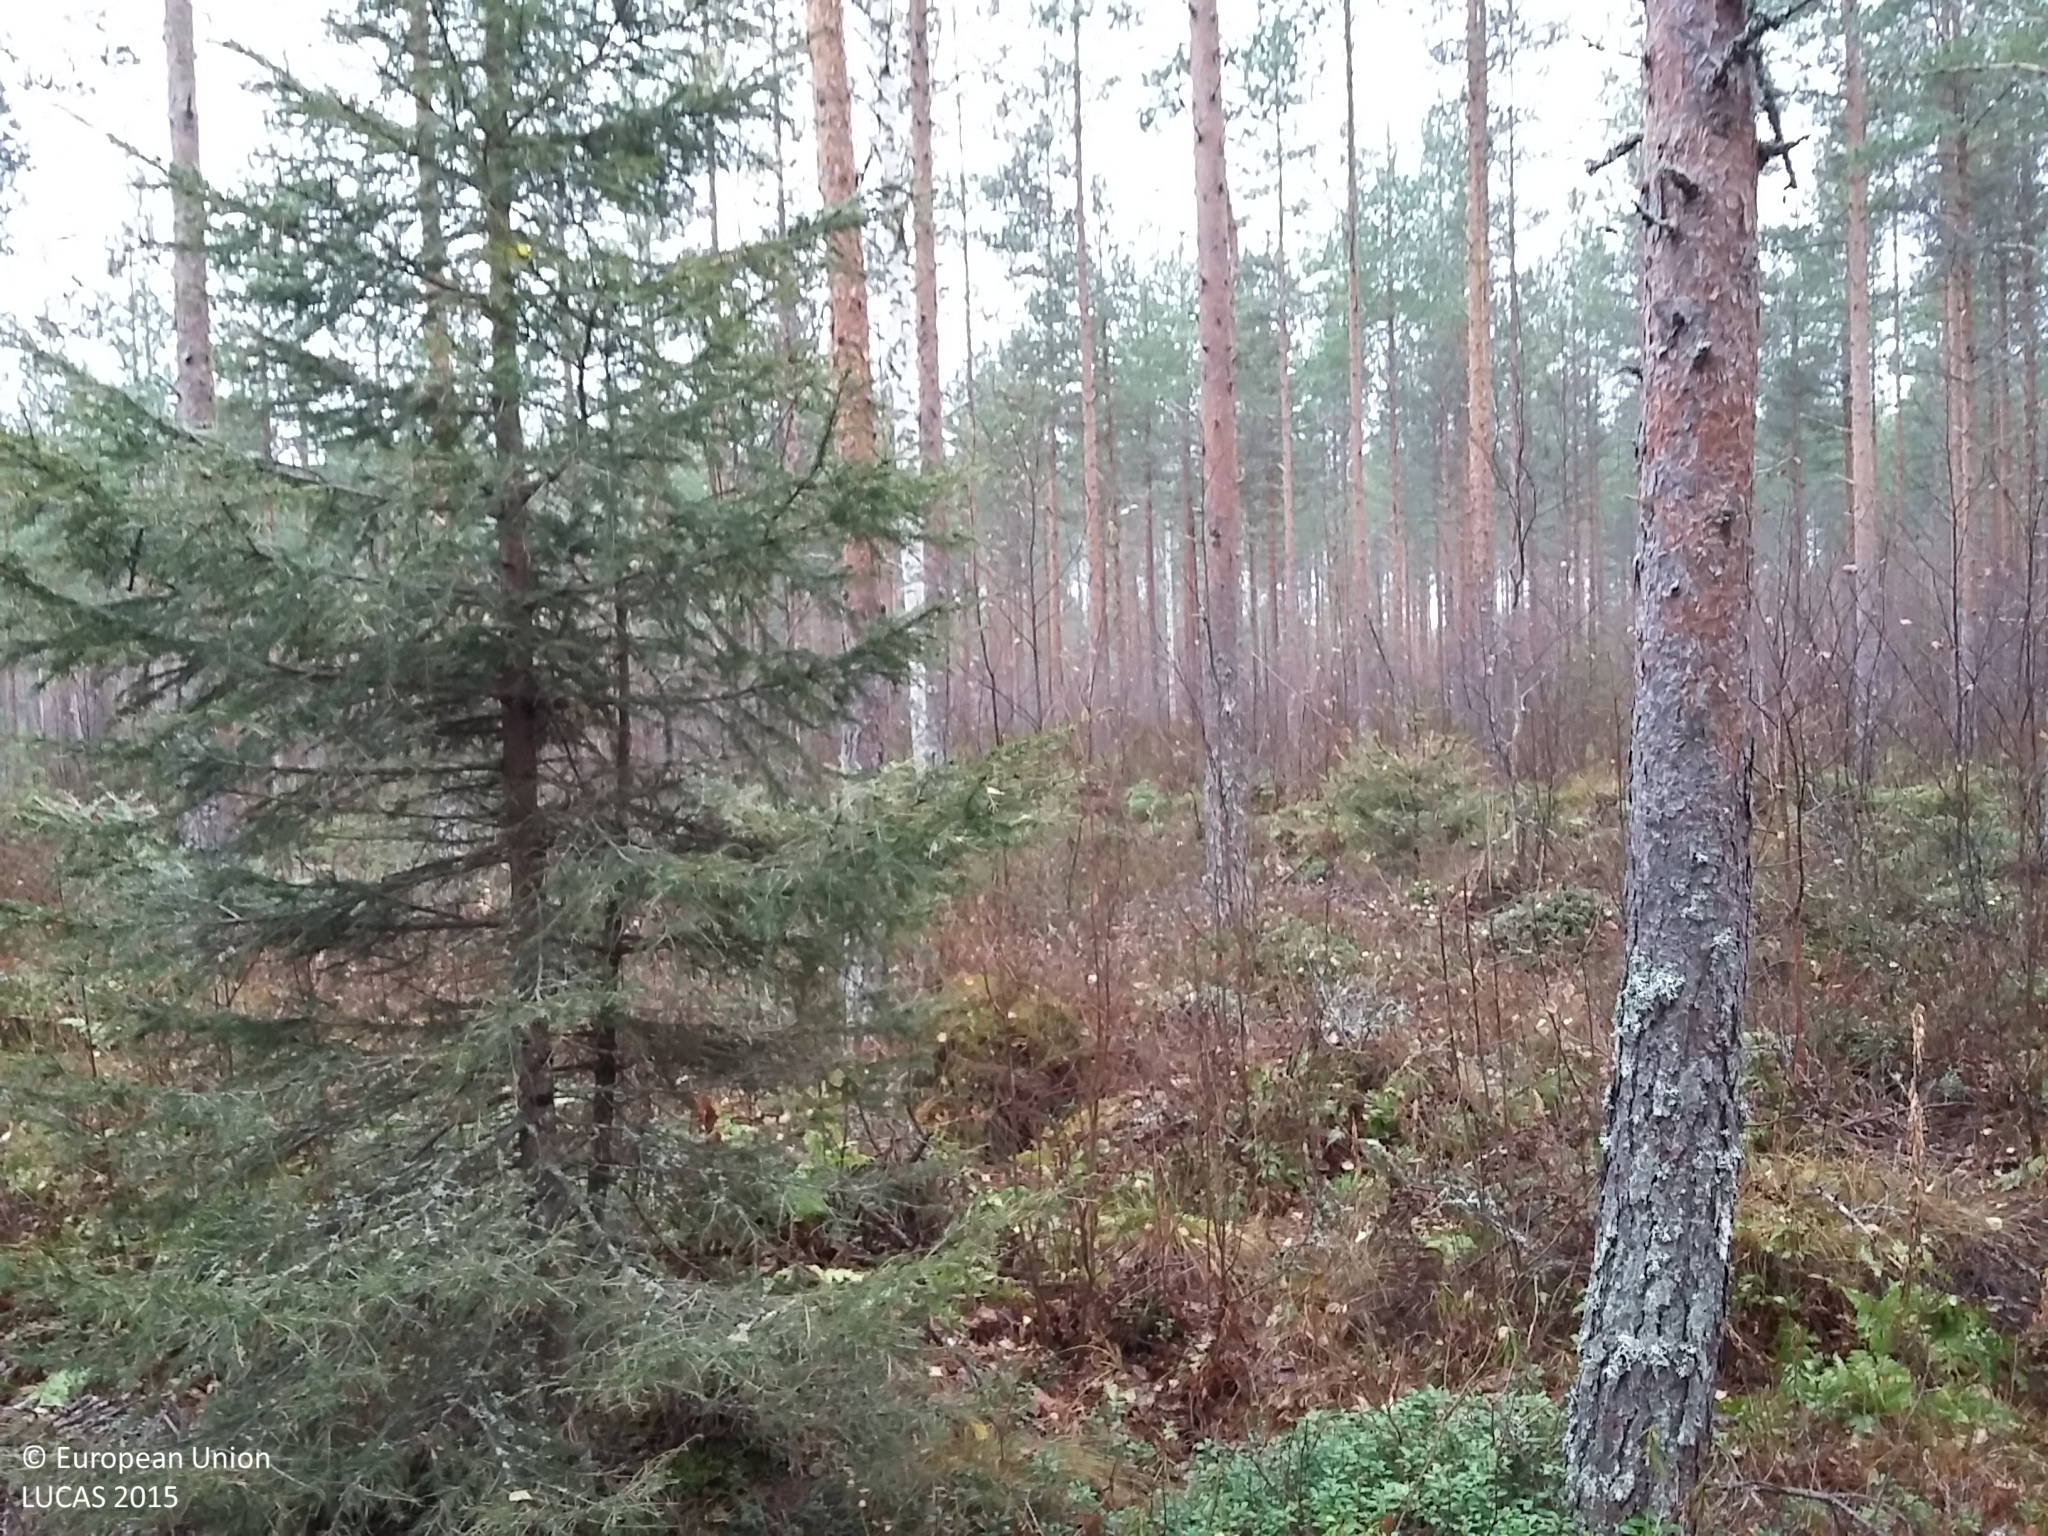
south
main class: Woodland
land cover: Pine dominated coniferous woodland
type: boreal forest
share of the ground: 50 - 75 %
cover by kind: coniferous forest trees 70 %, shrubs 20 %, lichens and mosses 10 %
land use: Forestry
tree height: > 5 m
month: October
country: FI
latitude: 64.3999
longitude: 25.3757
